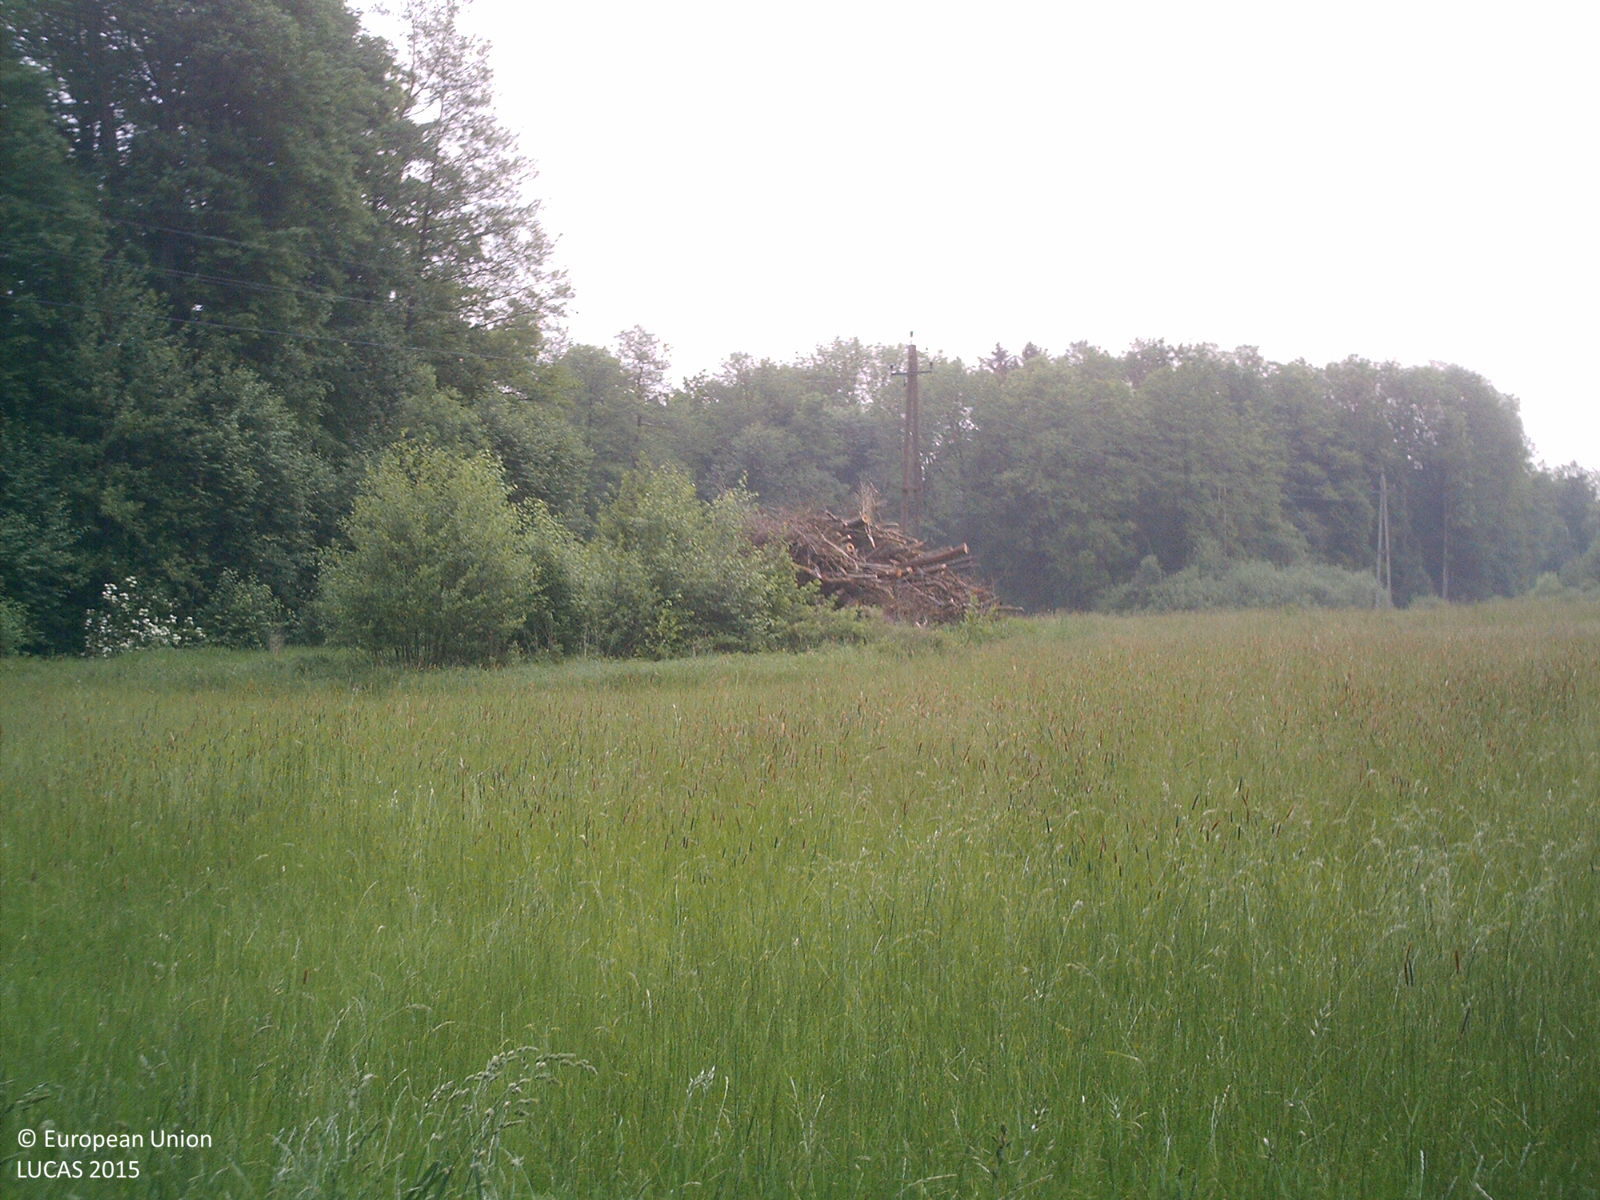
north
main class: Woodland
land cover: Broadleaved woodland
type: acidophilous oak and oak-birch forest
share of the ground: > 75 %
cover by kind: broadleaved forest trees 100 %
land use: Forestry
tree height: > 5 m
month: May
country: AT
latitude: 48.0755
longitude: 14.0934
